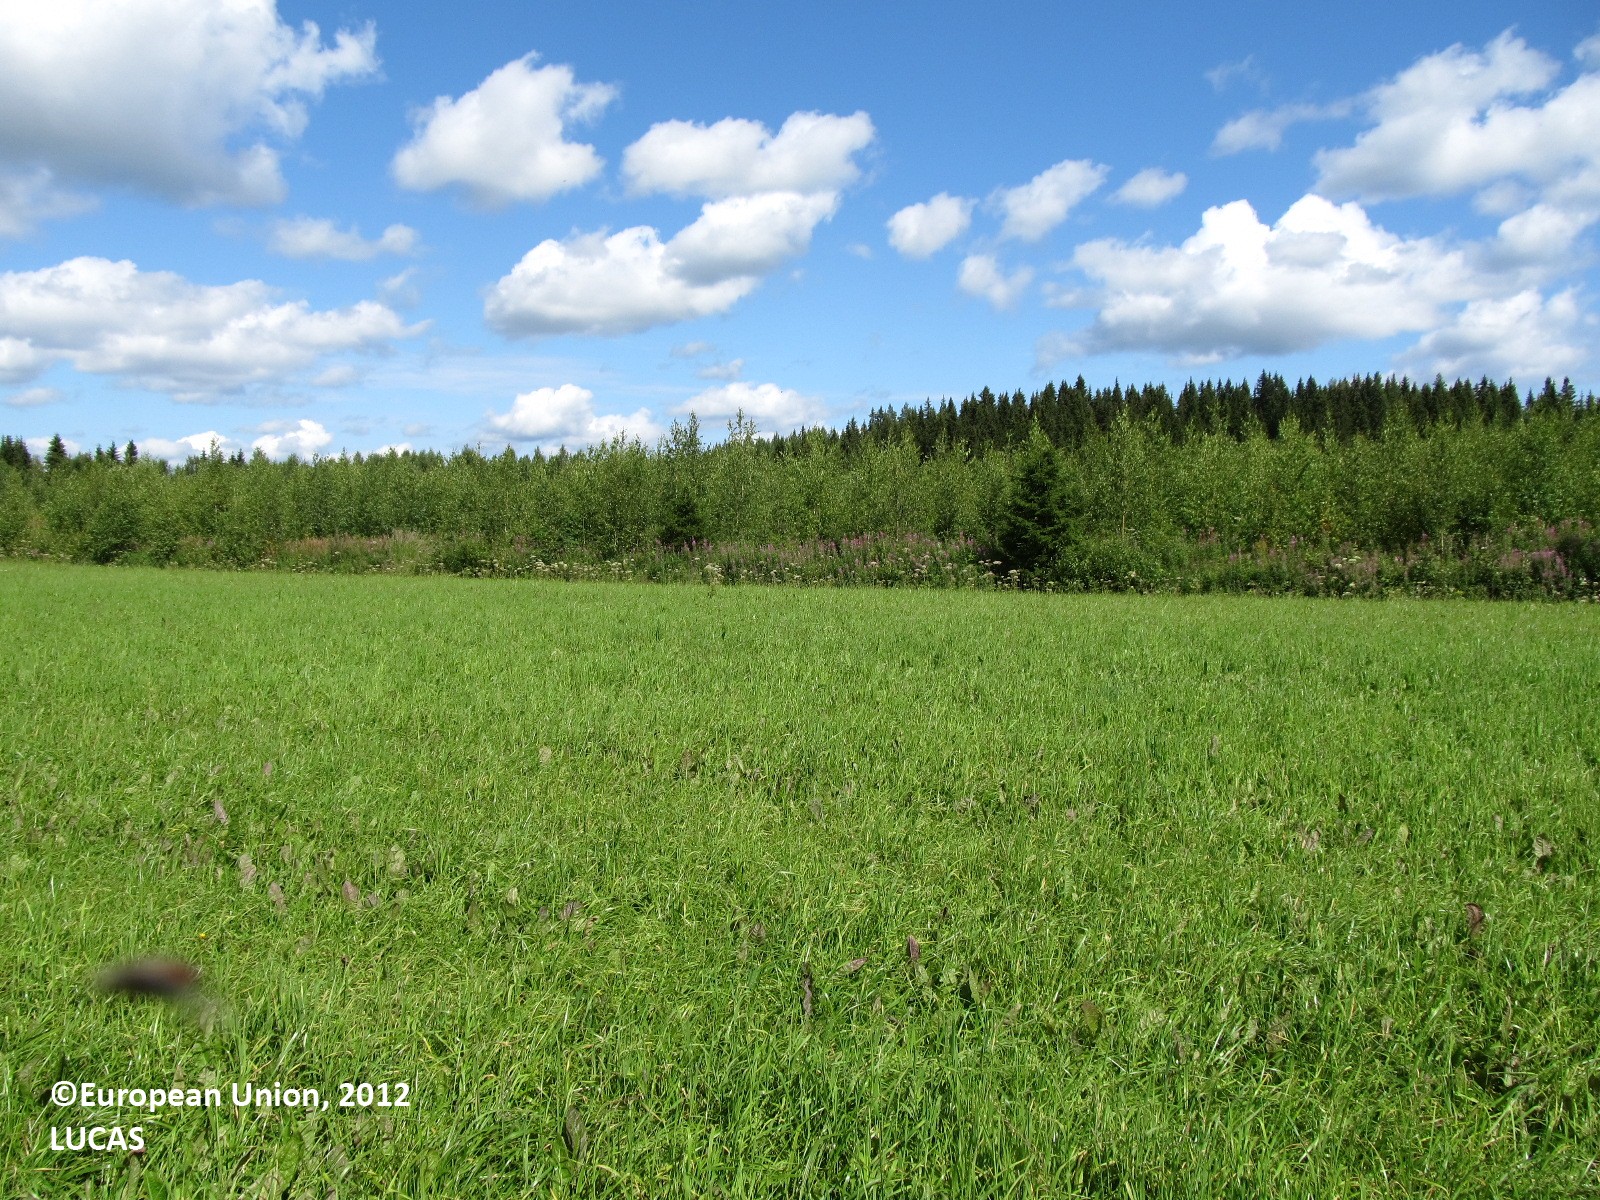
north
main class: Cropland
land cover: Temporary grasslands
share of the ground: 50 - 75 %
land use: Agriculture (excluding fallow land and kitchen gardens)
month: July
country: FI
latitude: 62.0567
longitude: 27.9583
